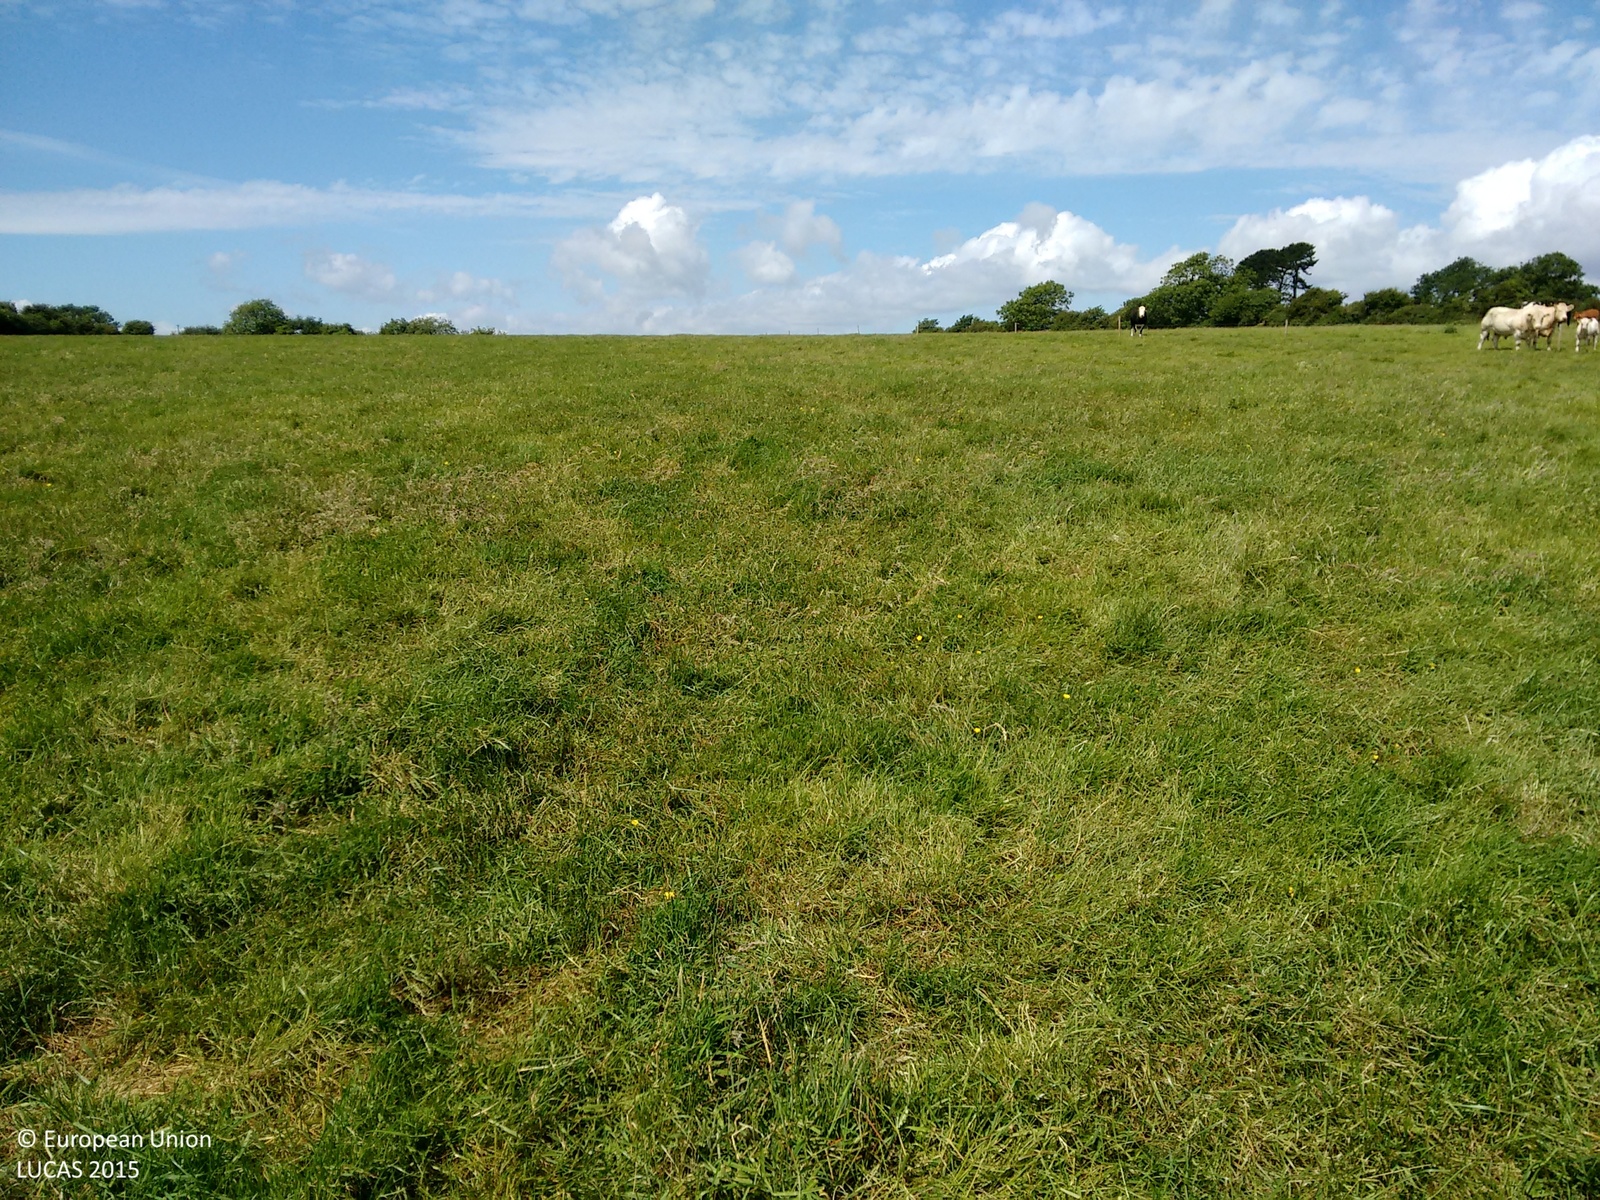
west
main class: Grassland
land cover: Grassland without tree/shrub cover
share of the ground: > 75 %
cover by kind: herbaceous plants 100 %
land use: Agriculture (excluding fallow land and kitchen gardens)
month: June
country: IE
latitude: 52.2162
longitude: -7.0498
